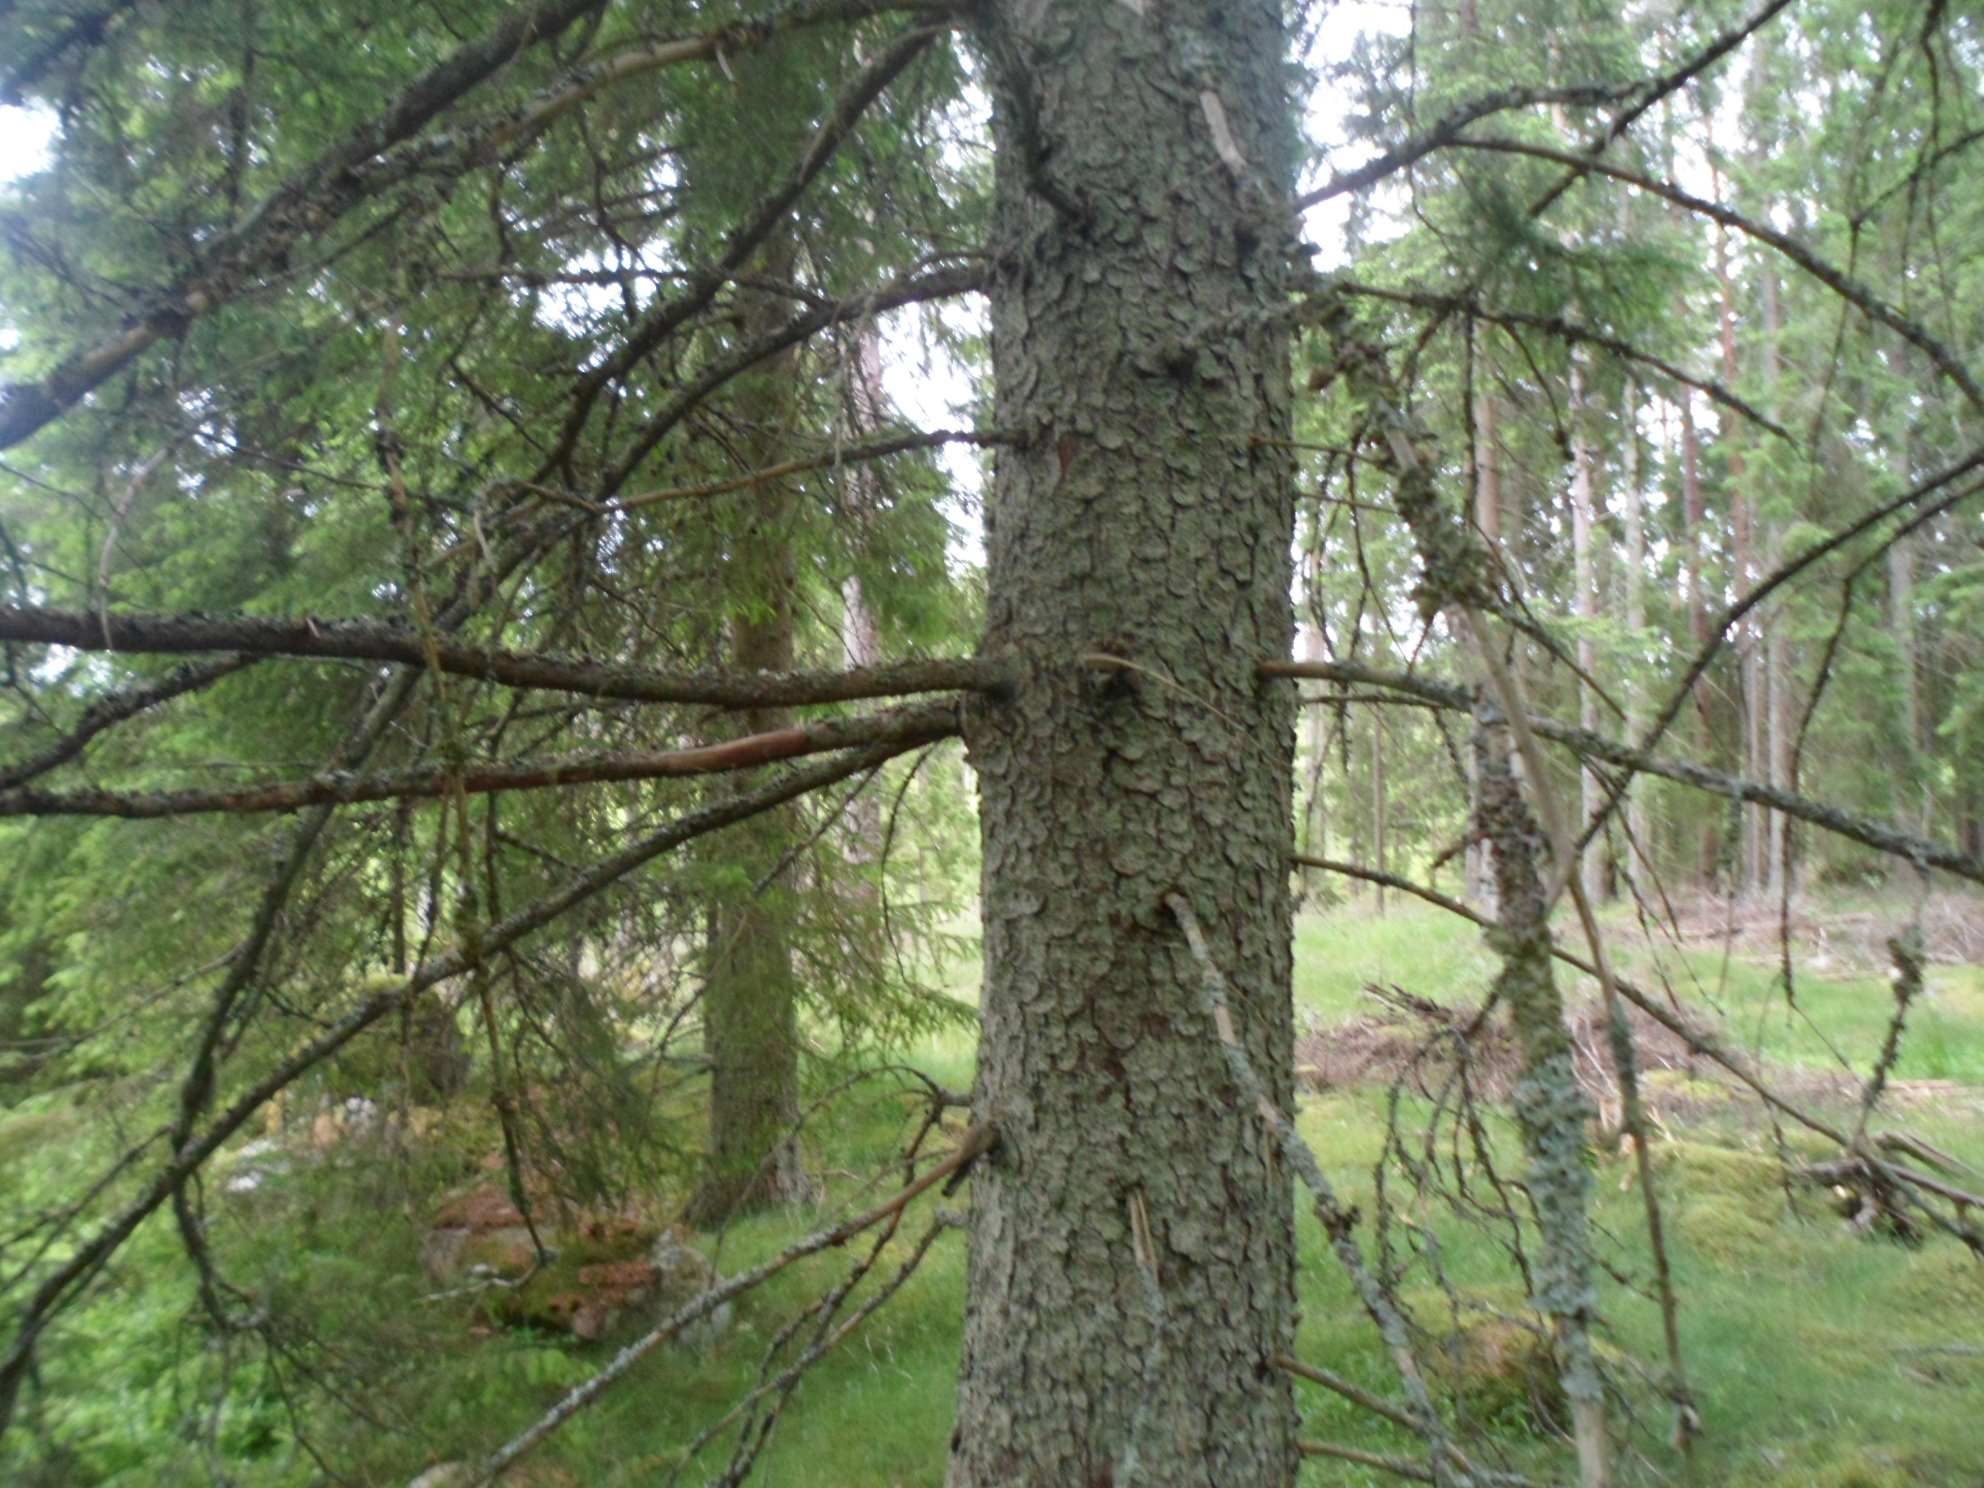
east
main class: Woodland
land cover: Spruce dominated coniferous woodland
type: boreal forest
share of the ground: 50 - 75 %
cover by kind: coniferous forest trees 60 %, shrubs 15 %, herbaceous plants 15 %, lichens and mosses 10 %
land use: Forestry
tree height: > 5 m
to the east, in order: Spruce dominated coniferous woodland; Spruce dominated mixed woodland; Grassland with sparse tree/shrub cover; Electric lines; Spruce dominated coniferous woodland; Pine dominated coniferous woodland; Spruce dominated coniferous woodland; Tracks; Spruce dominated coniferous woodland
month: June
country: SE
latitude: 57.0231
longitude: 15.5494
